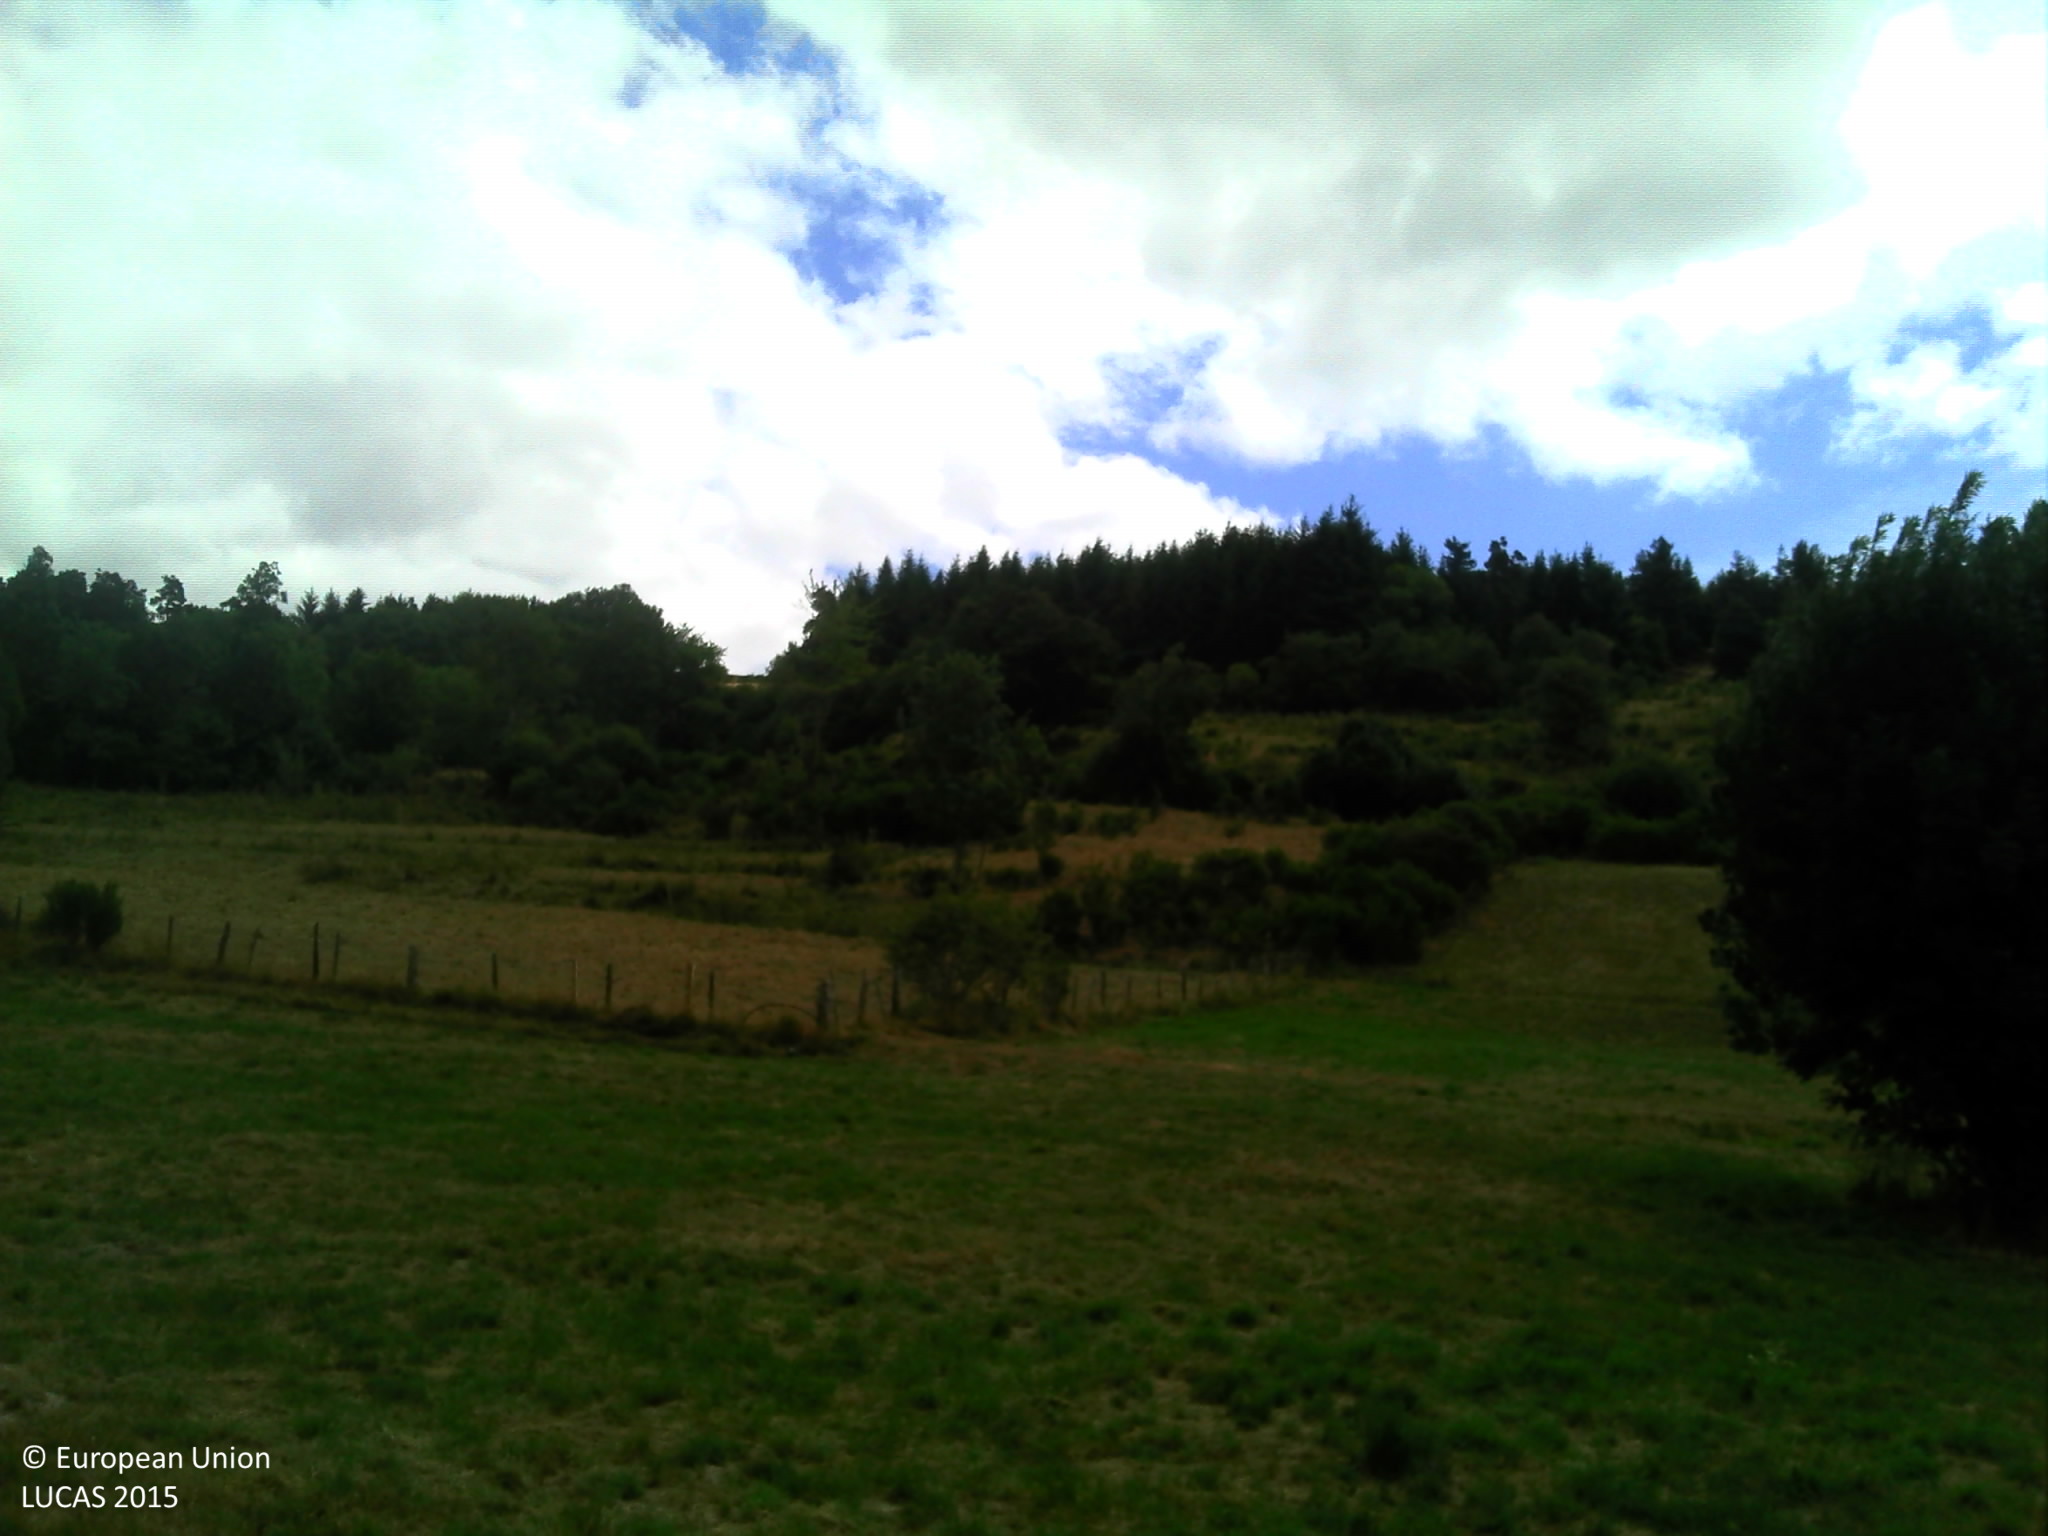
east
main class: Grassland
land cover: Grassland without tree/shrub cover
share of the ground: > 75 %
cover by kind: herbaceous plants 100 %
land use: Agriculture (excluding fallow land and kitchen gardens)
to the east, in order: Grassland without tree/shrub cover; Fences; Shrubland with sparse tree cover; Grassland without tree/shrub cover; Tracks; Grassland without tree/shrub cover; Abandoned hedges; Grassland without tree/shrub cover; Spruce dominated mixed woodland; Shrubland with sparse tree cover
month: July
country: FR
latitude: 44.6395
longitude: 3.2847
